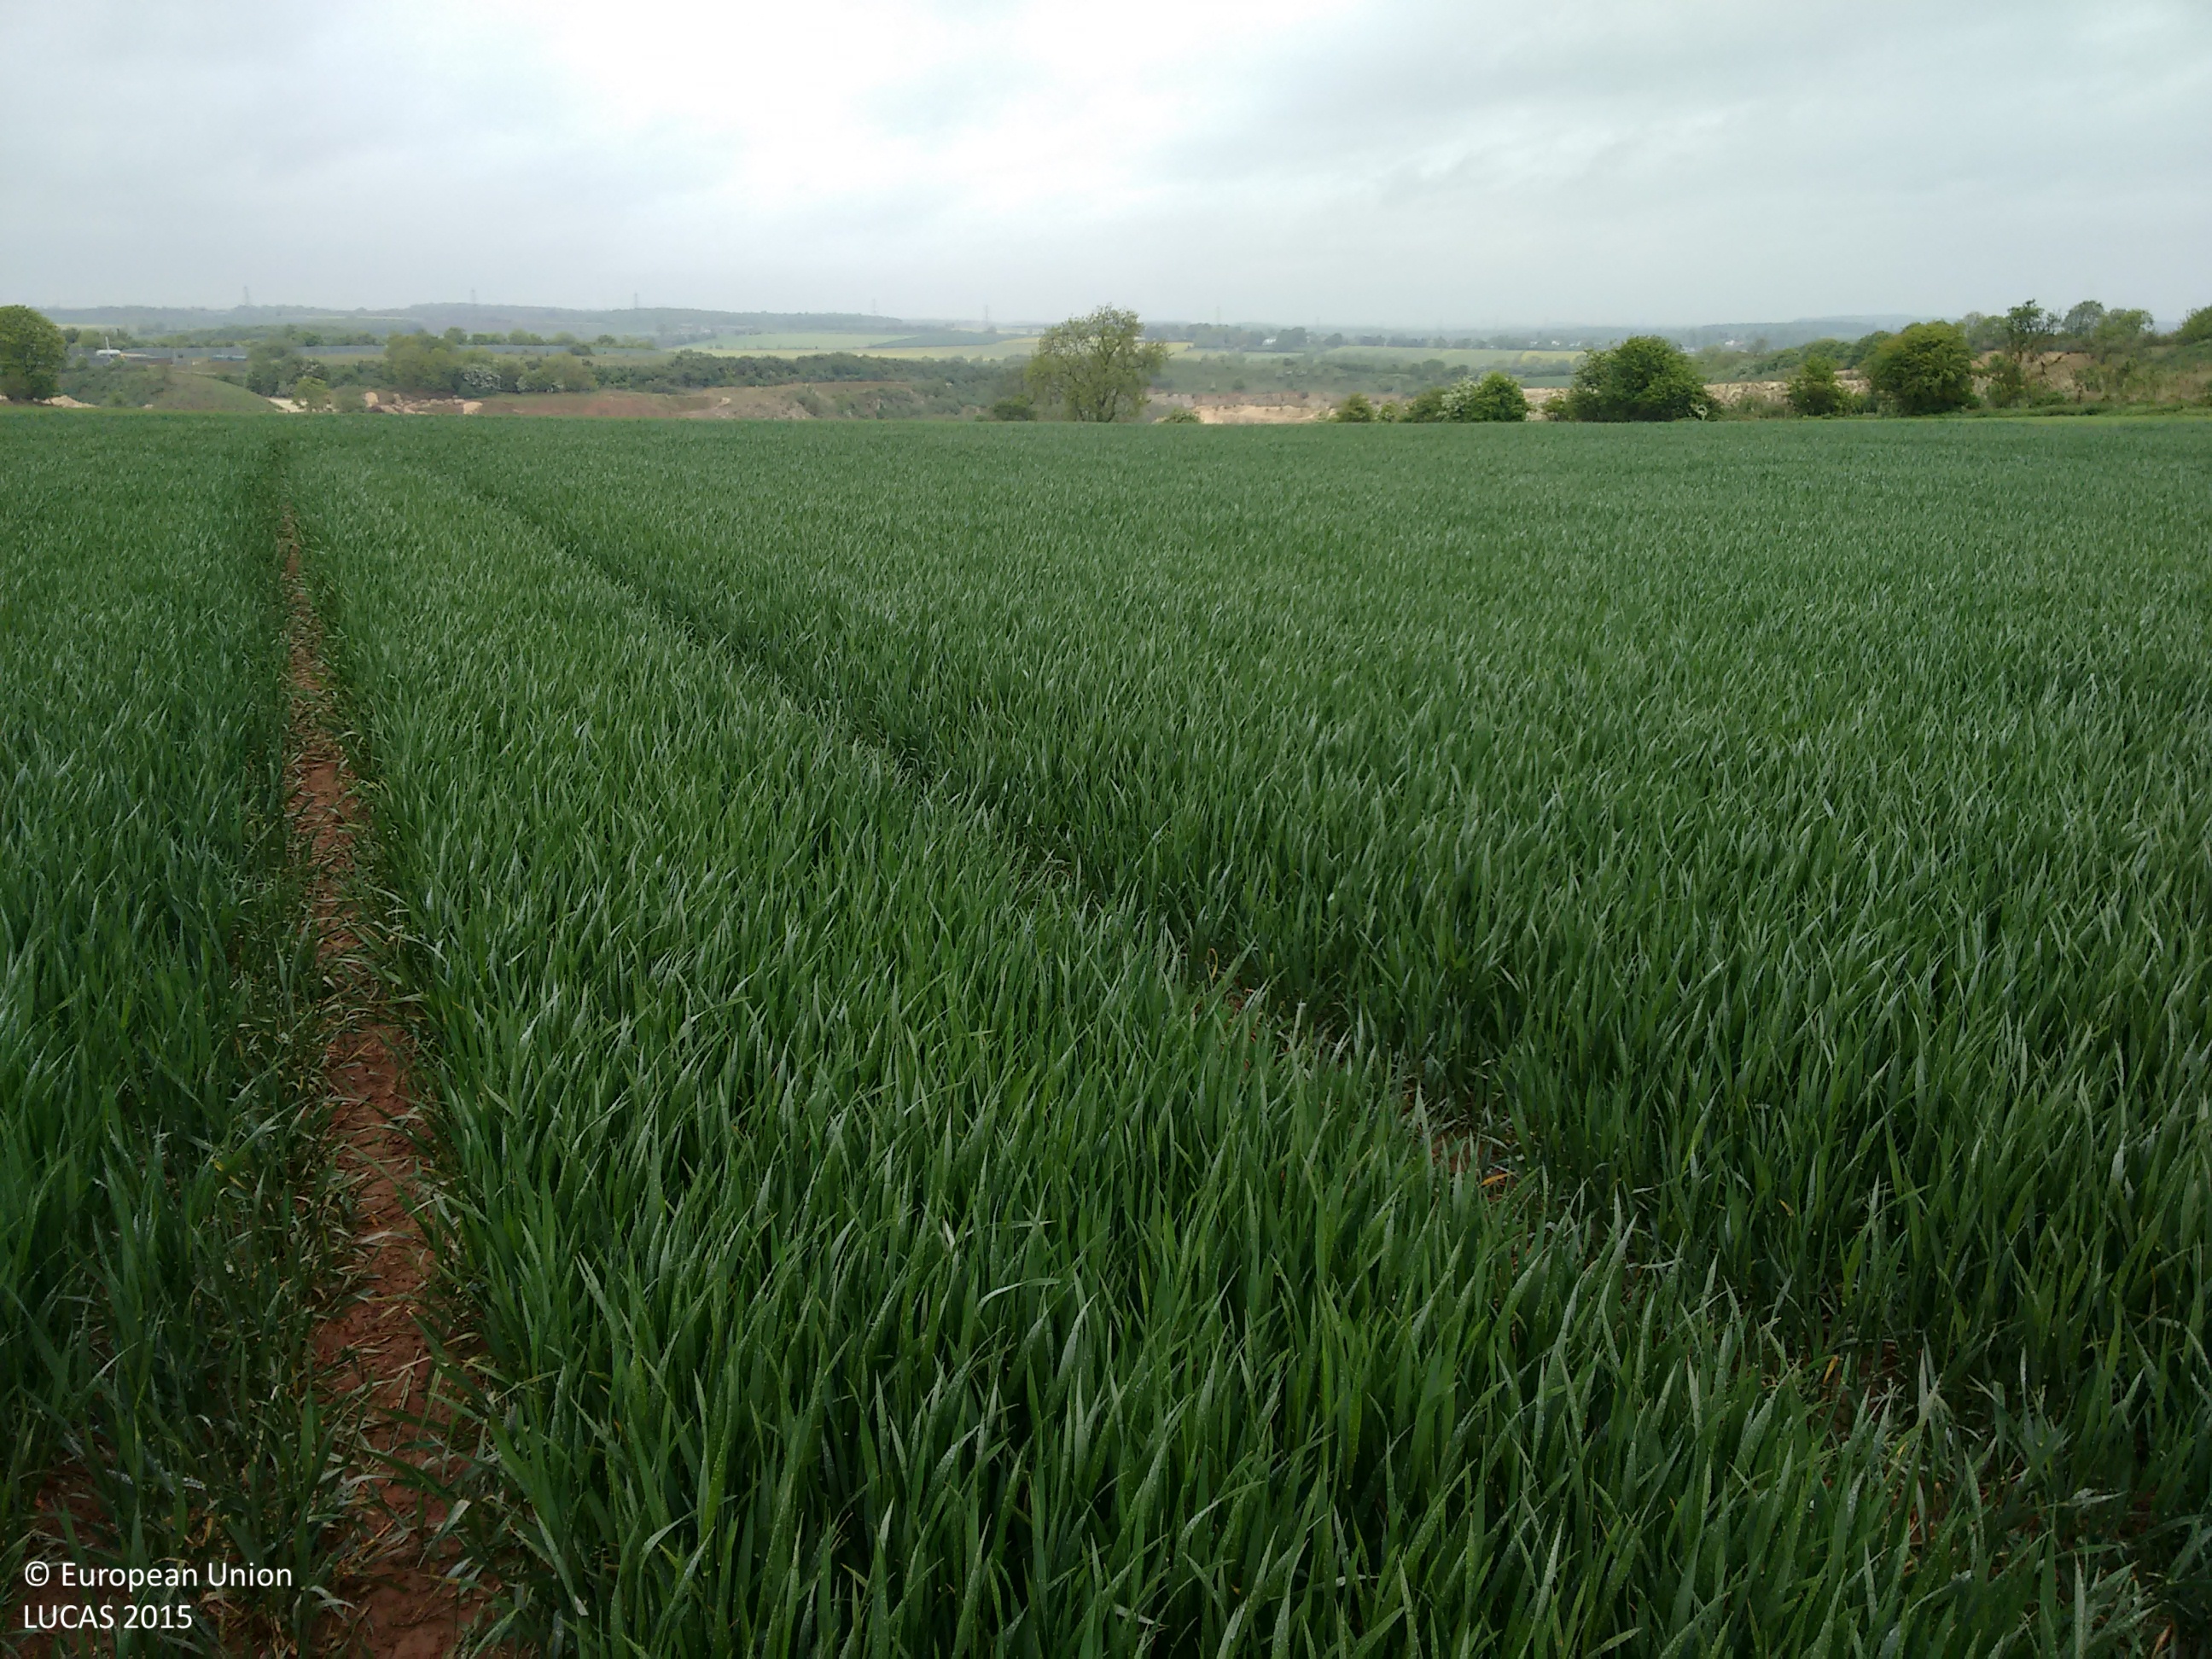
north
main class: Cropland
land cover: Common wheat
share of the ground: > 75 %
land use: Agriculture (excluding fallow land and kitchen gardens)
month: May
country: GB
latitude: 53.6232
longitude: -1.2193
